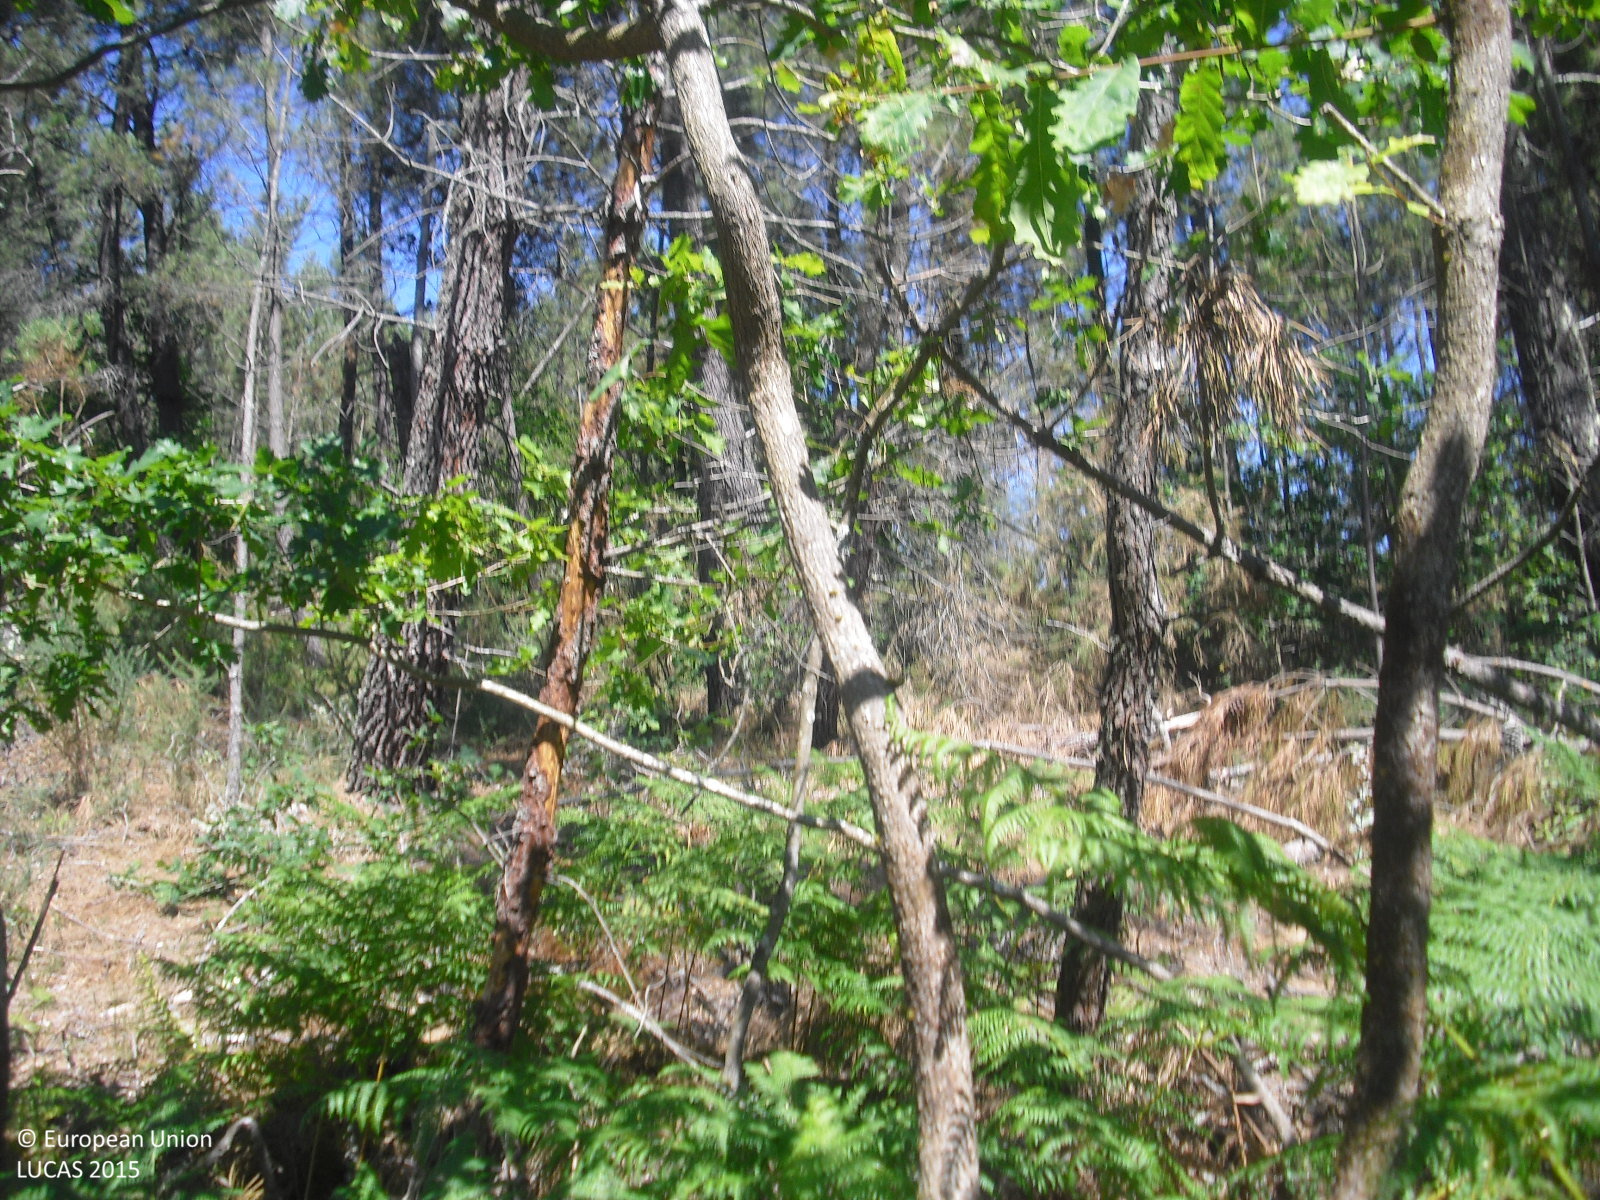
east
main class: Woodland
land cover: Pine dominated mixed woodland
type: hemiboreal forest and nemoral coniferous forest and mixed broadleaved-coniferous forest
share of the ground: 25 - 50 %
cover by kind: coniferous forest trees 40 %, shrubs 35 %, broadleaved forest trees 15 %, herbaceous plants 10 %
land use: Forestry
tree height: > 5 m
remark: Clear cut
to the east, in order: Pine dominated mixed woodland; Dry stone walls; Tracks; Pine dominated mixed woodland; Dry stone walls; Ditches and canals; Dry stone walls; Pine dominated mixed woodland; Tracks; Pine dominated mixed woodland; Broadleaved woodland; Shrubland without tree cover; Grassland without tree/shrub cover; Shrubland without tree cover; Broadleaved woodland; Grassland without tree/shrub cover
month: June
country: ES
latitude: 42.4517
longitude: -7.7675
